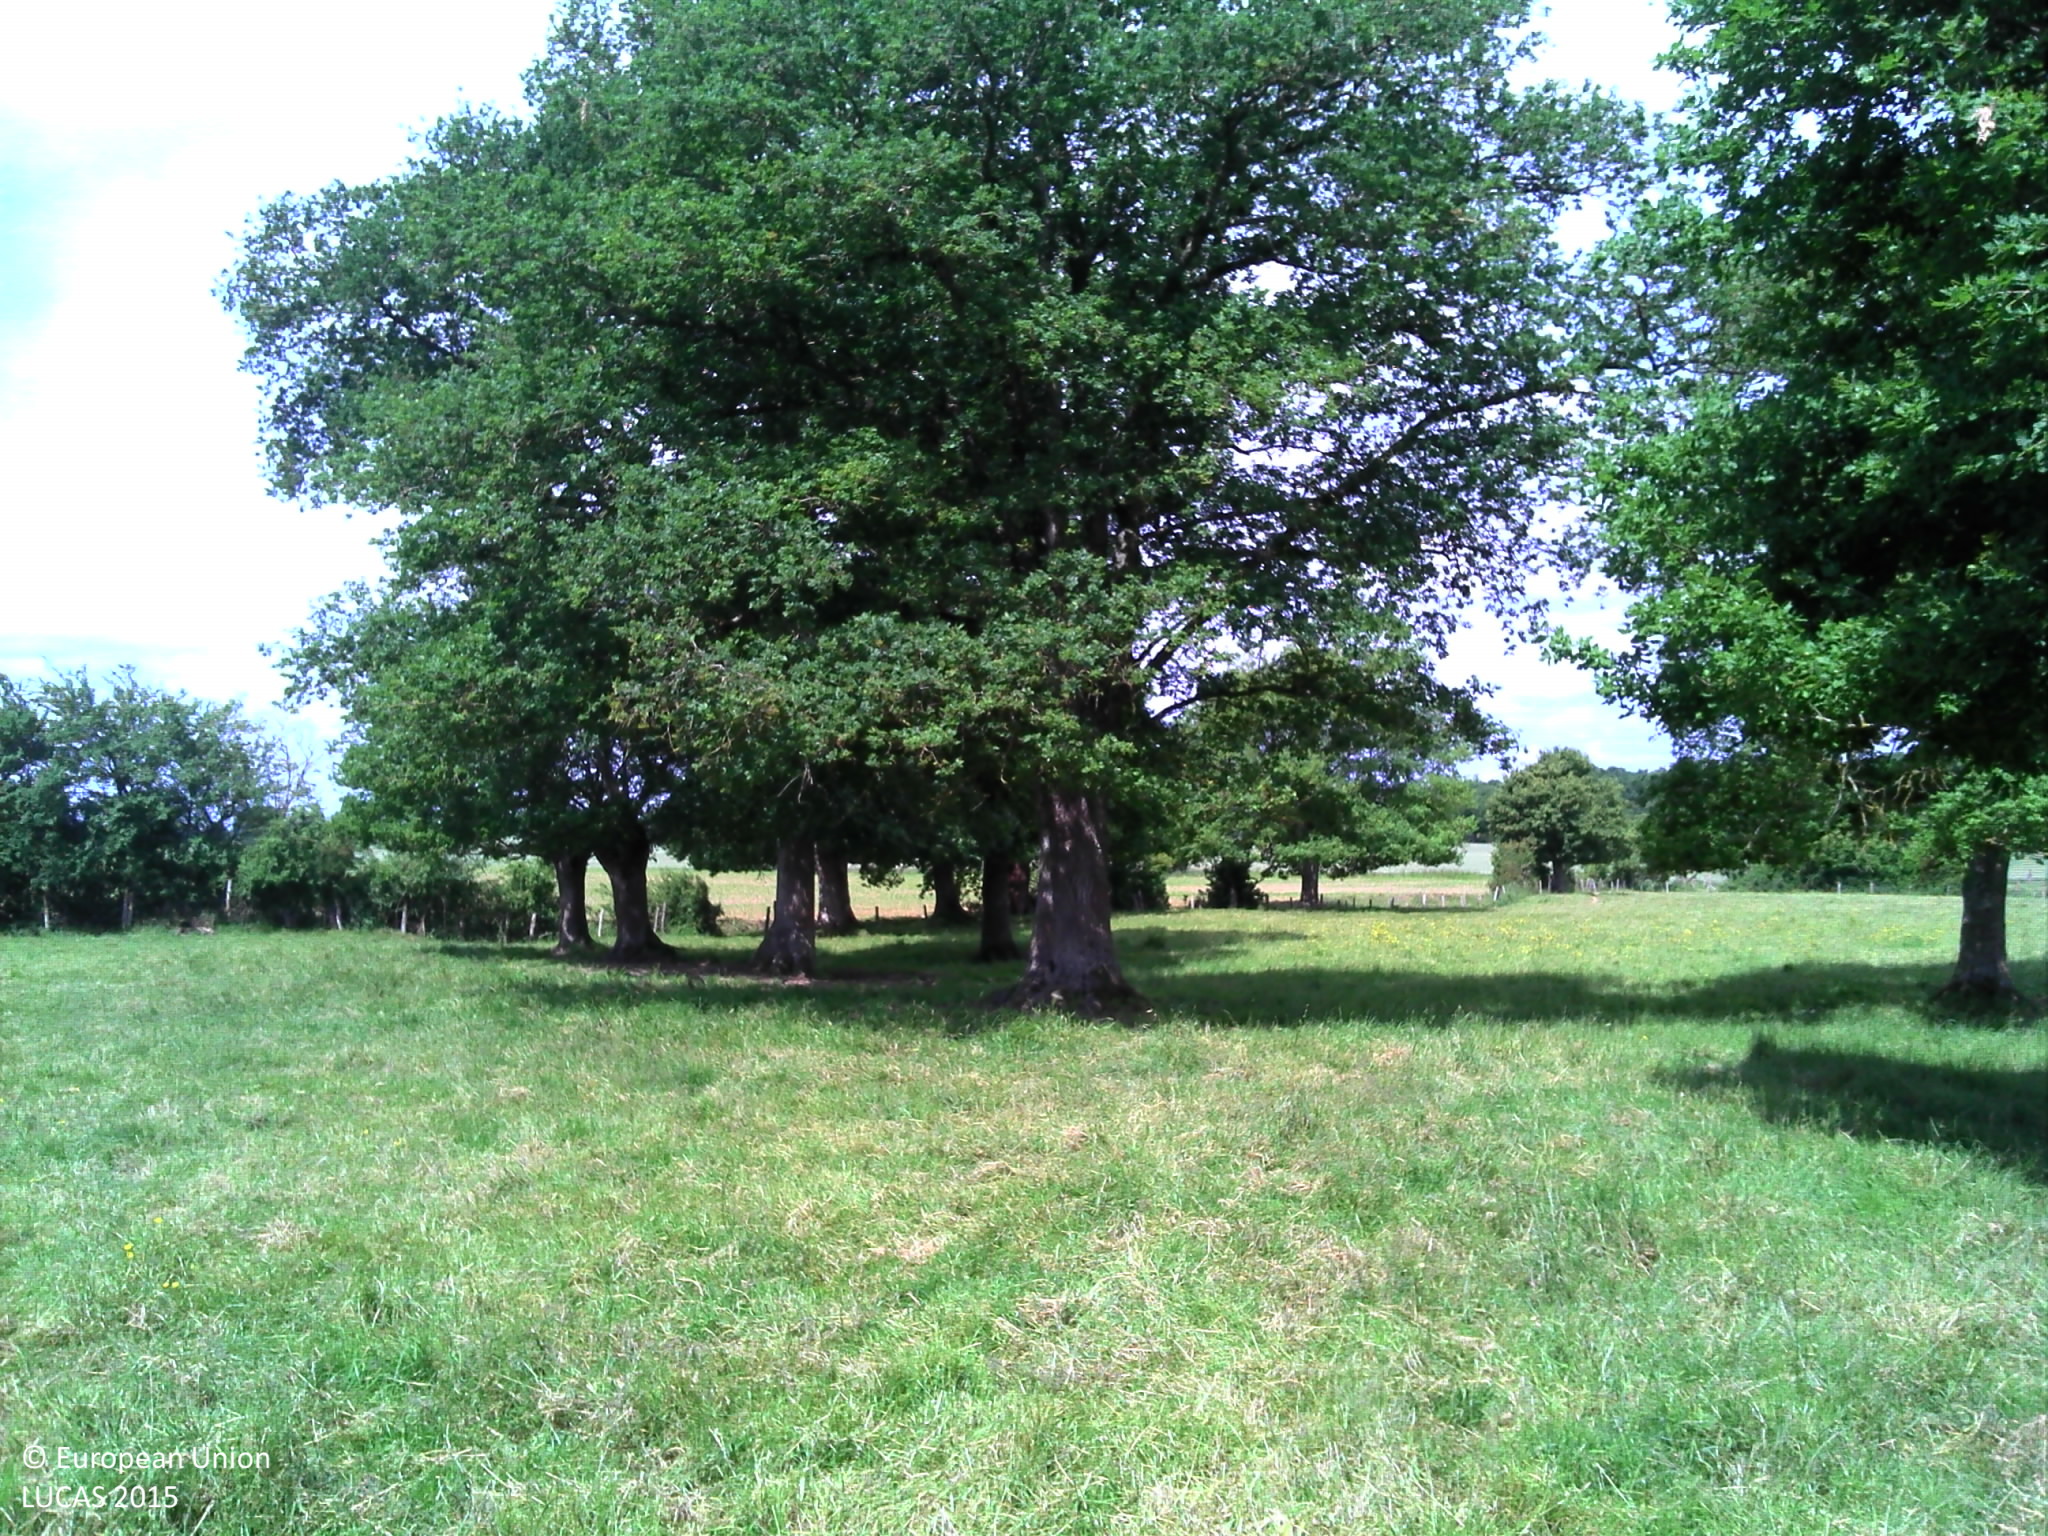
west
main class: Grassland
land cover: Grassland with sparse tree/shrub cover
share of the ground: > 75 %
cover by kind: herbaceous plants 95 %, broadleaved forest trees 5 %
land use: Agriculture (excluding fallow land and kitchen gardens)
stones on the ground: < 10 %
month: May
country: FR
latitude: 47.9666
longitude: -0.0064
